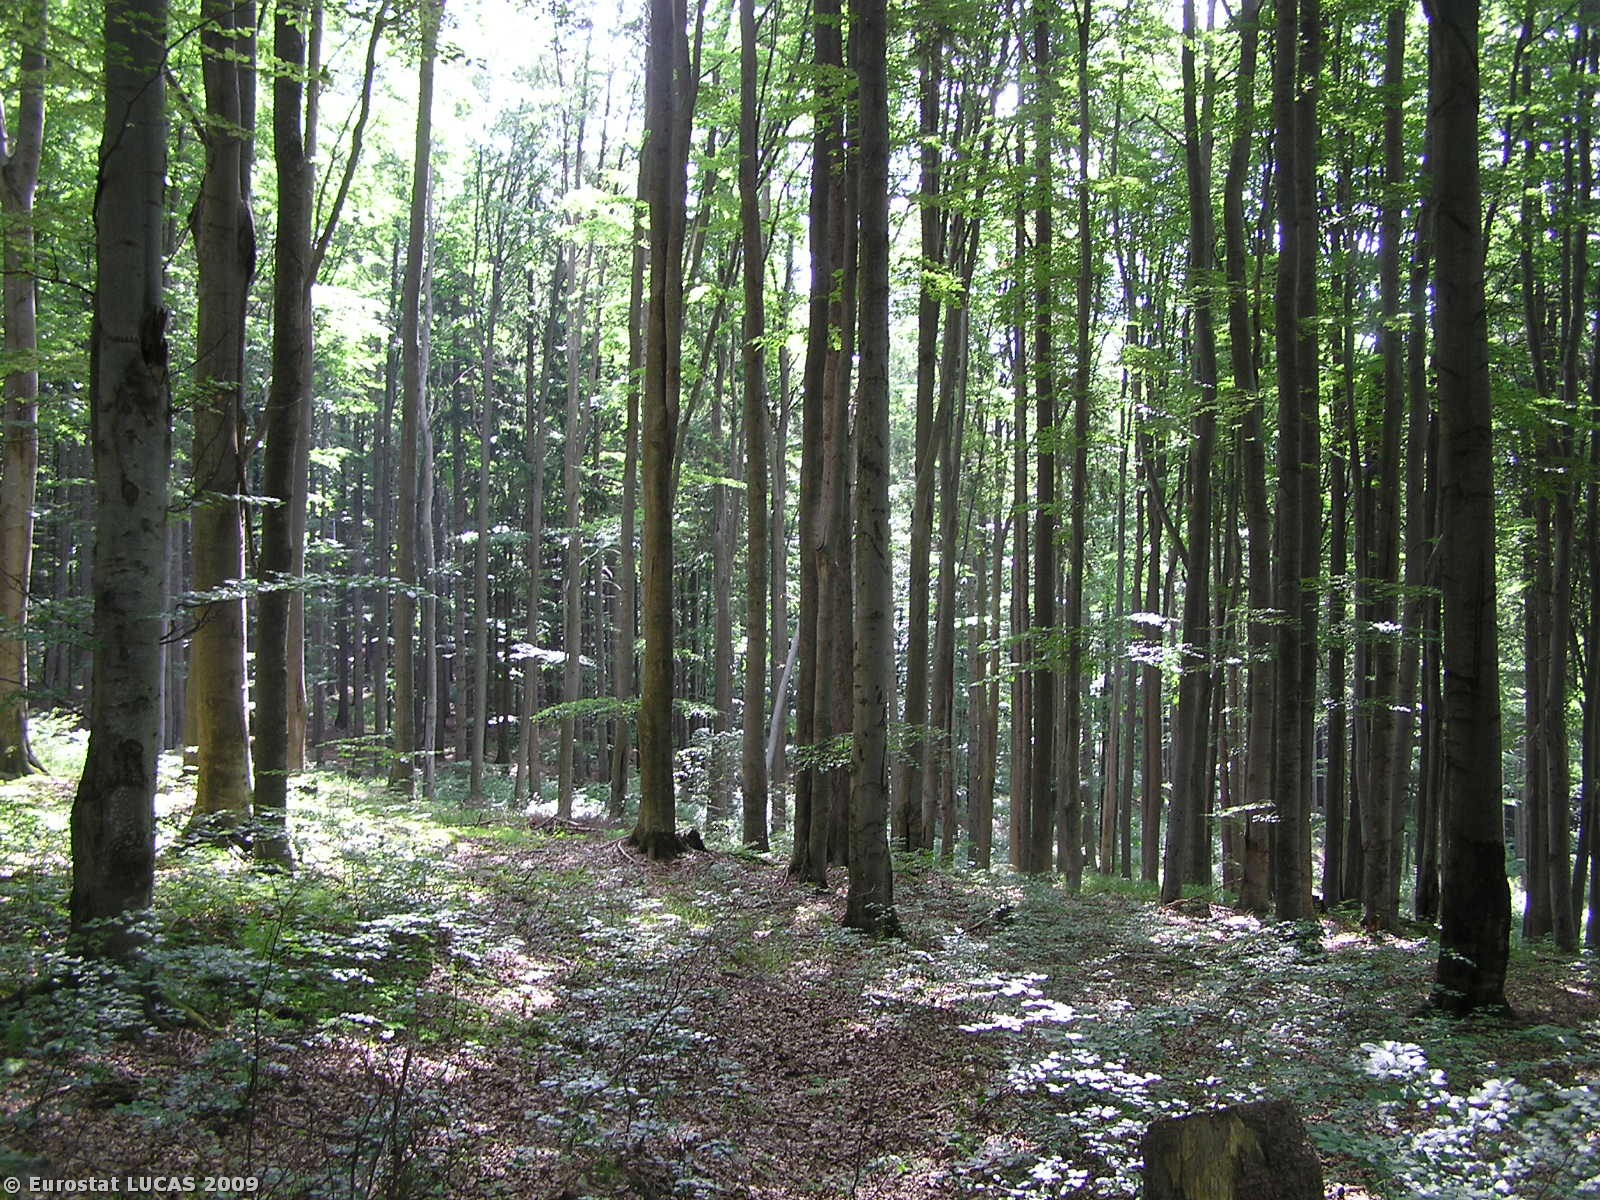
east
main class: Woodland
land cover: Broadleaved woodland
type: mountainous beech forest
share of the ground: > 75 %
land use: Forestry
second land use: Nature reserves
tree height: > 5 m
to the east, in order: Broadleaved woodland
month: July
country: CZ
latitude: 50.0931
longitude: 17.3221
